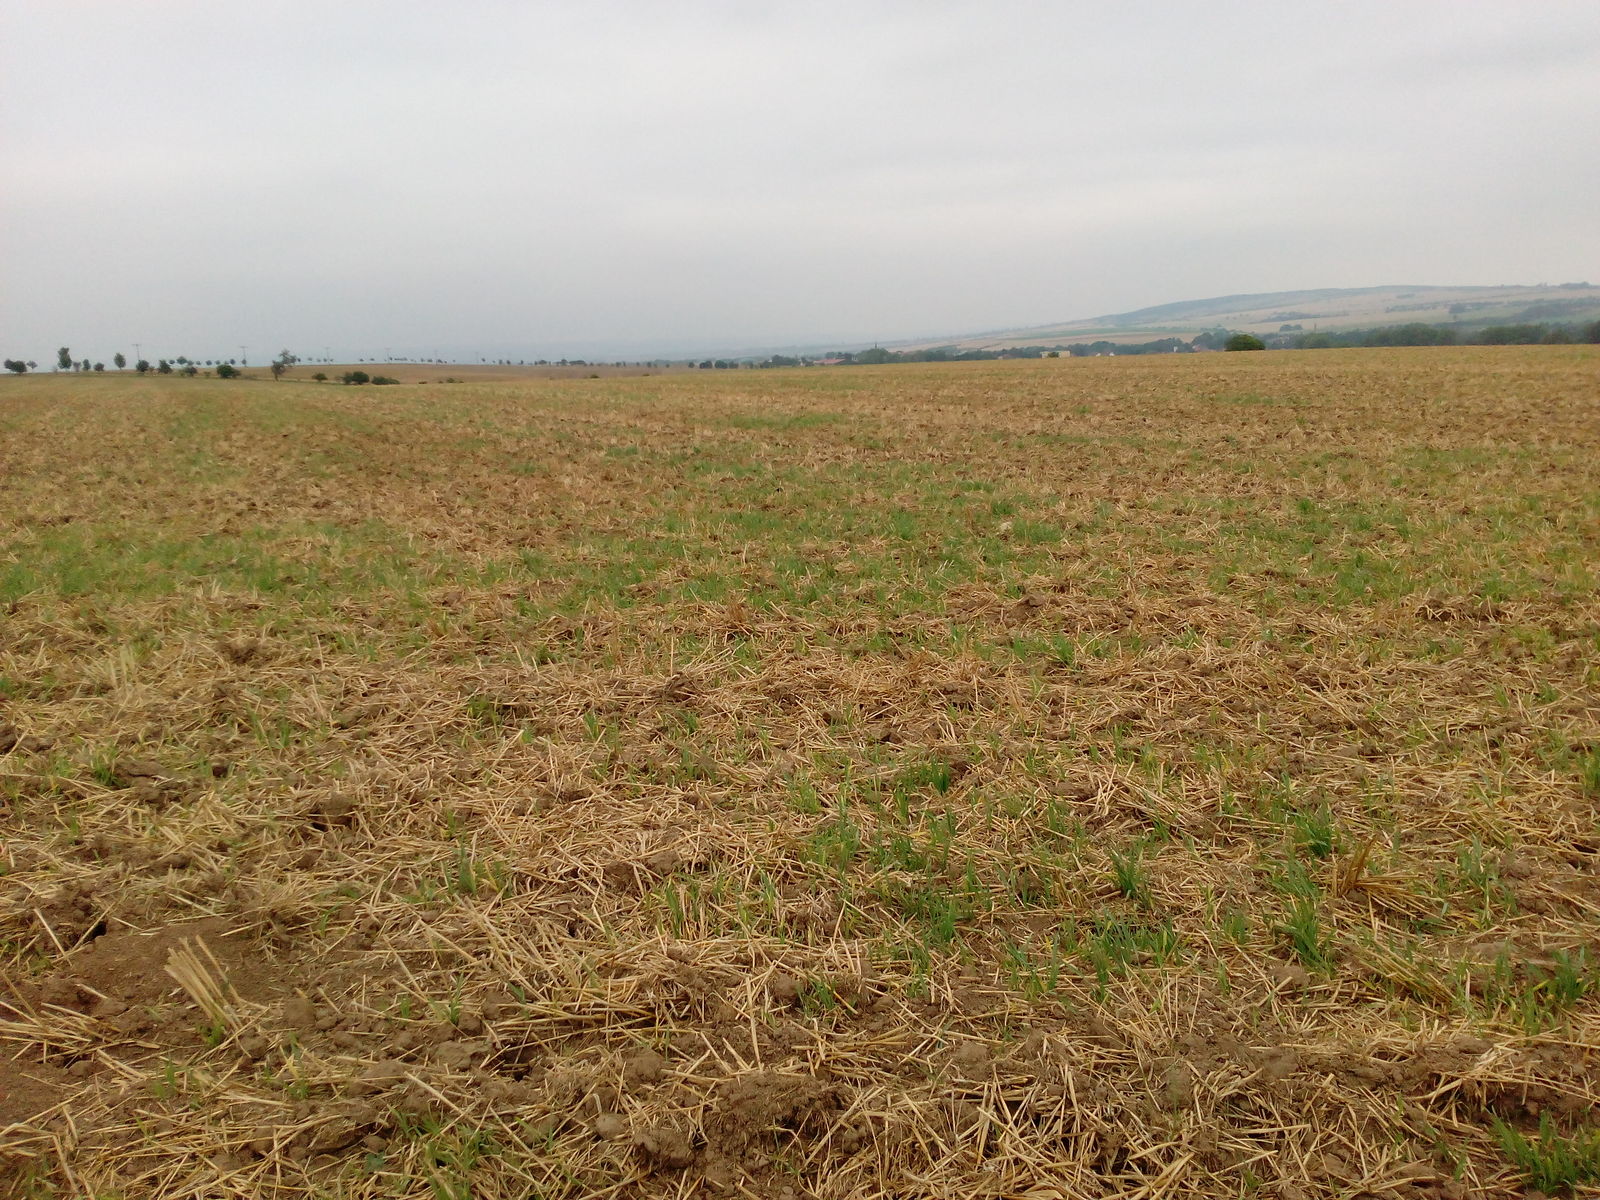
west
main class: Cropland
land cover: Barley
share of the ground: 10 - 25 %
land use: Agriculture (excluding fallow land and kitchen gardens)
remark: Harvested field
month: August
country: DE
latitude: 51.2254
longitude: 10.6156
